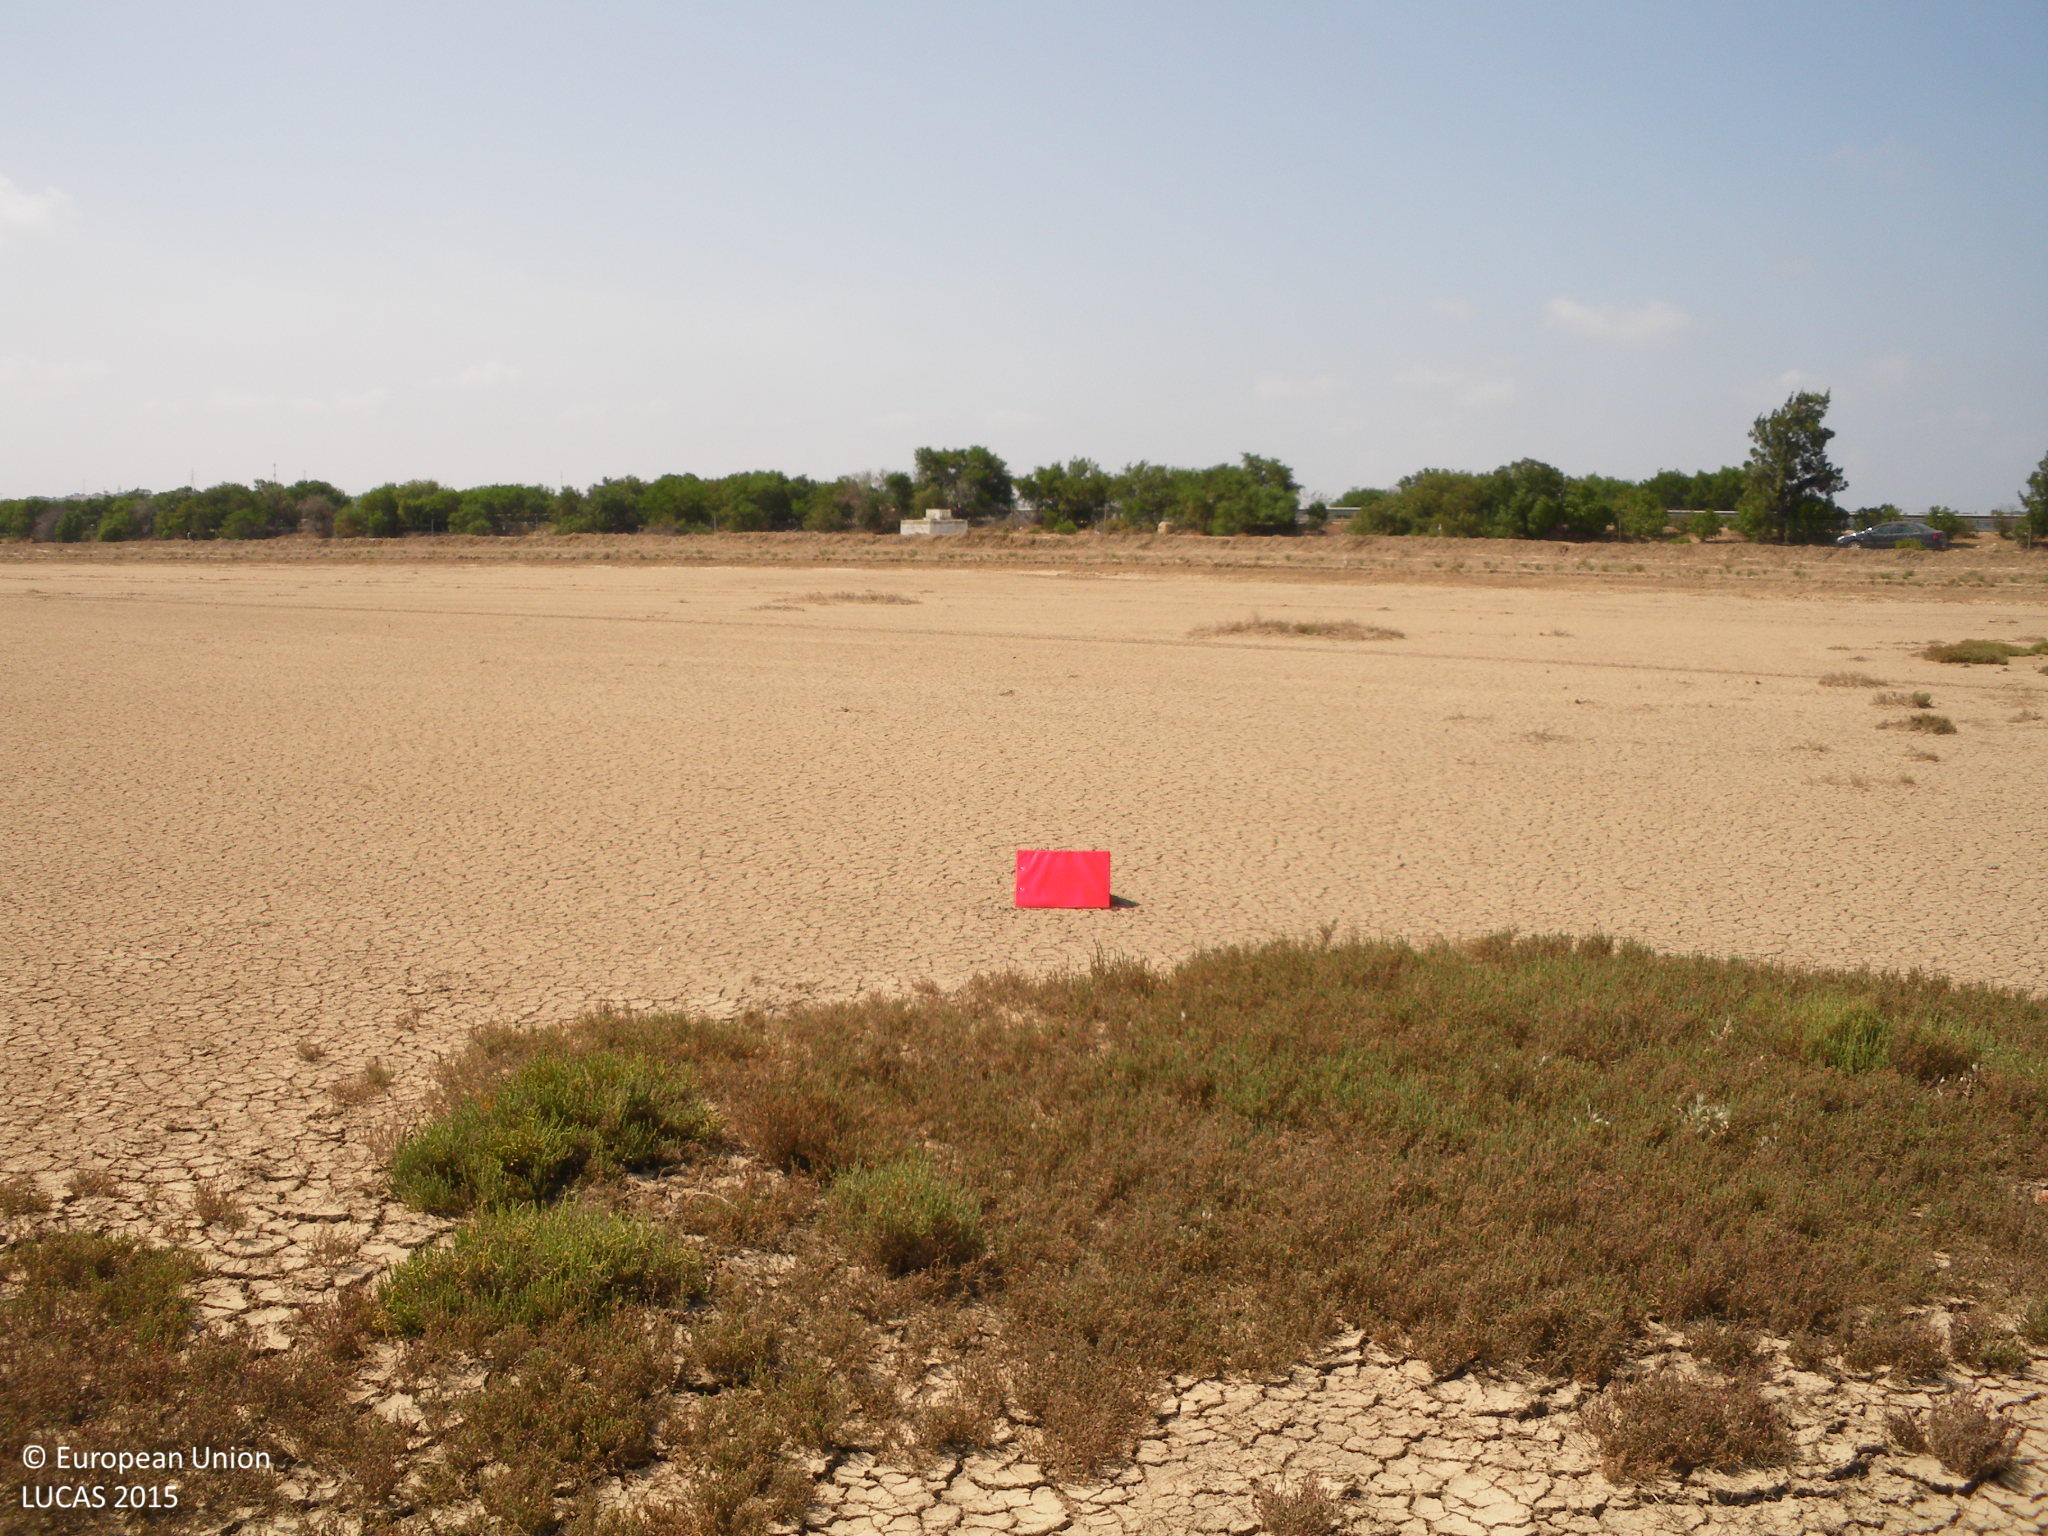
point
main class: Shrubland
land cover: Shrubland without tree cover
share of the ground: 10 - 25 %
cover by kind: unconsolidated bare surface 80 %, shrubs 20 %
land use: Semi-natural and natural areas not in use
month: May
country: ES
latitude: 36.5555
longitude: -6.1766
